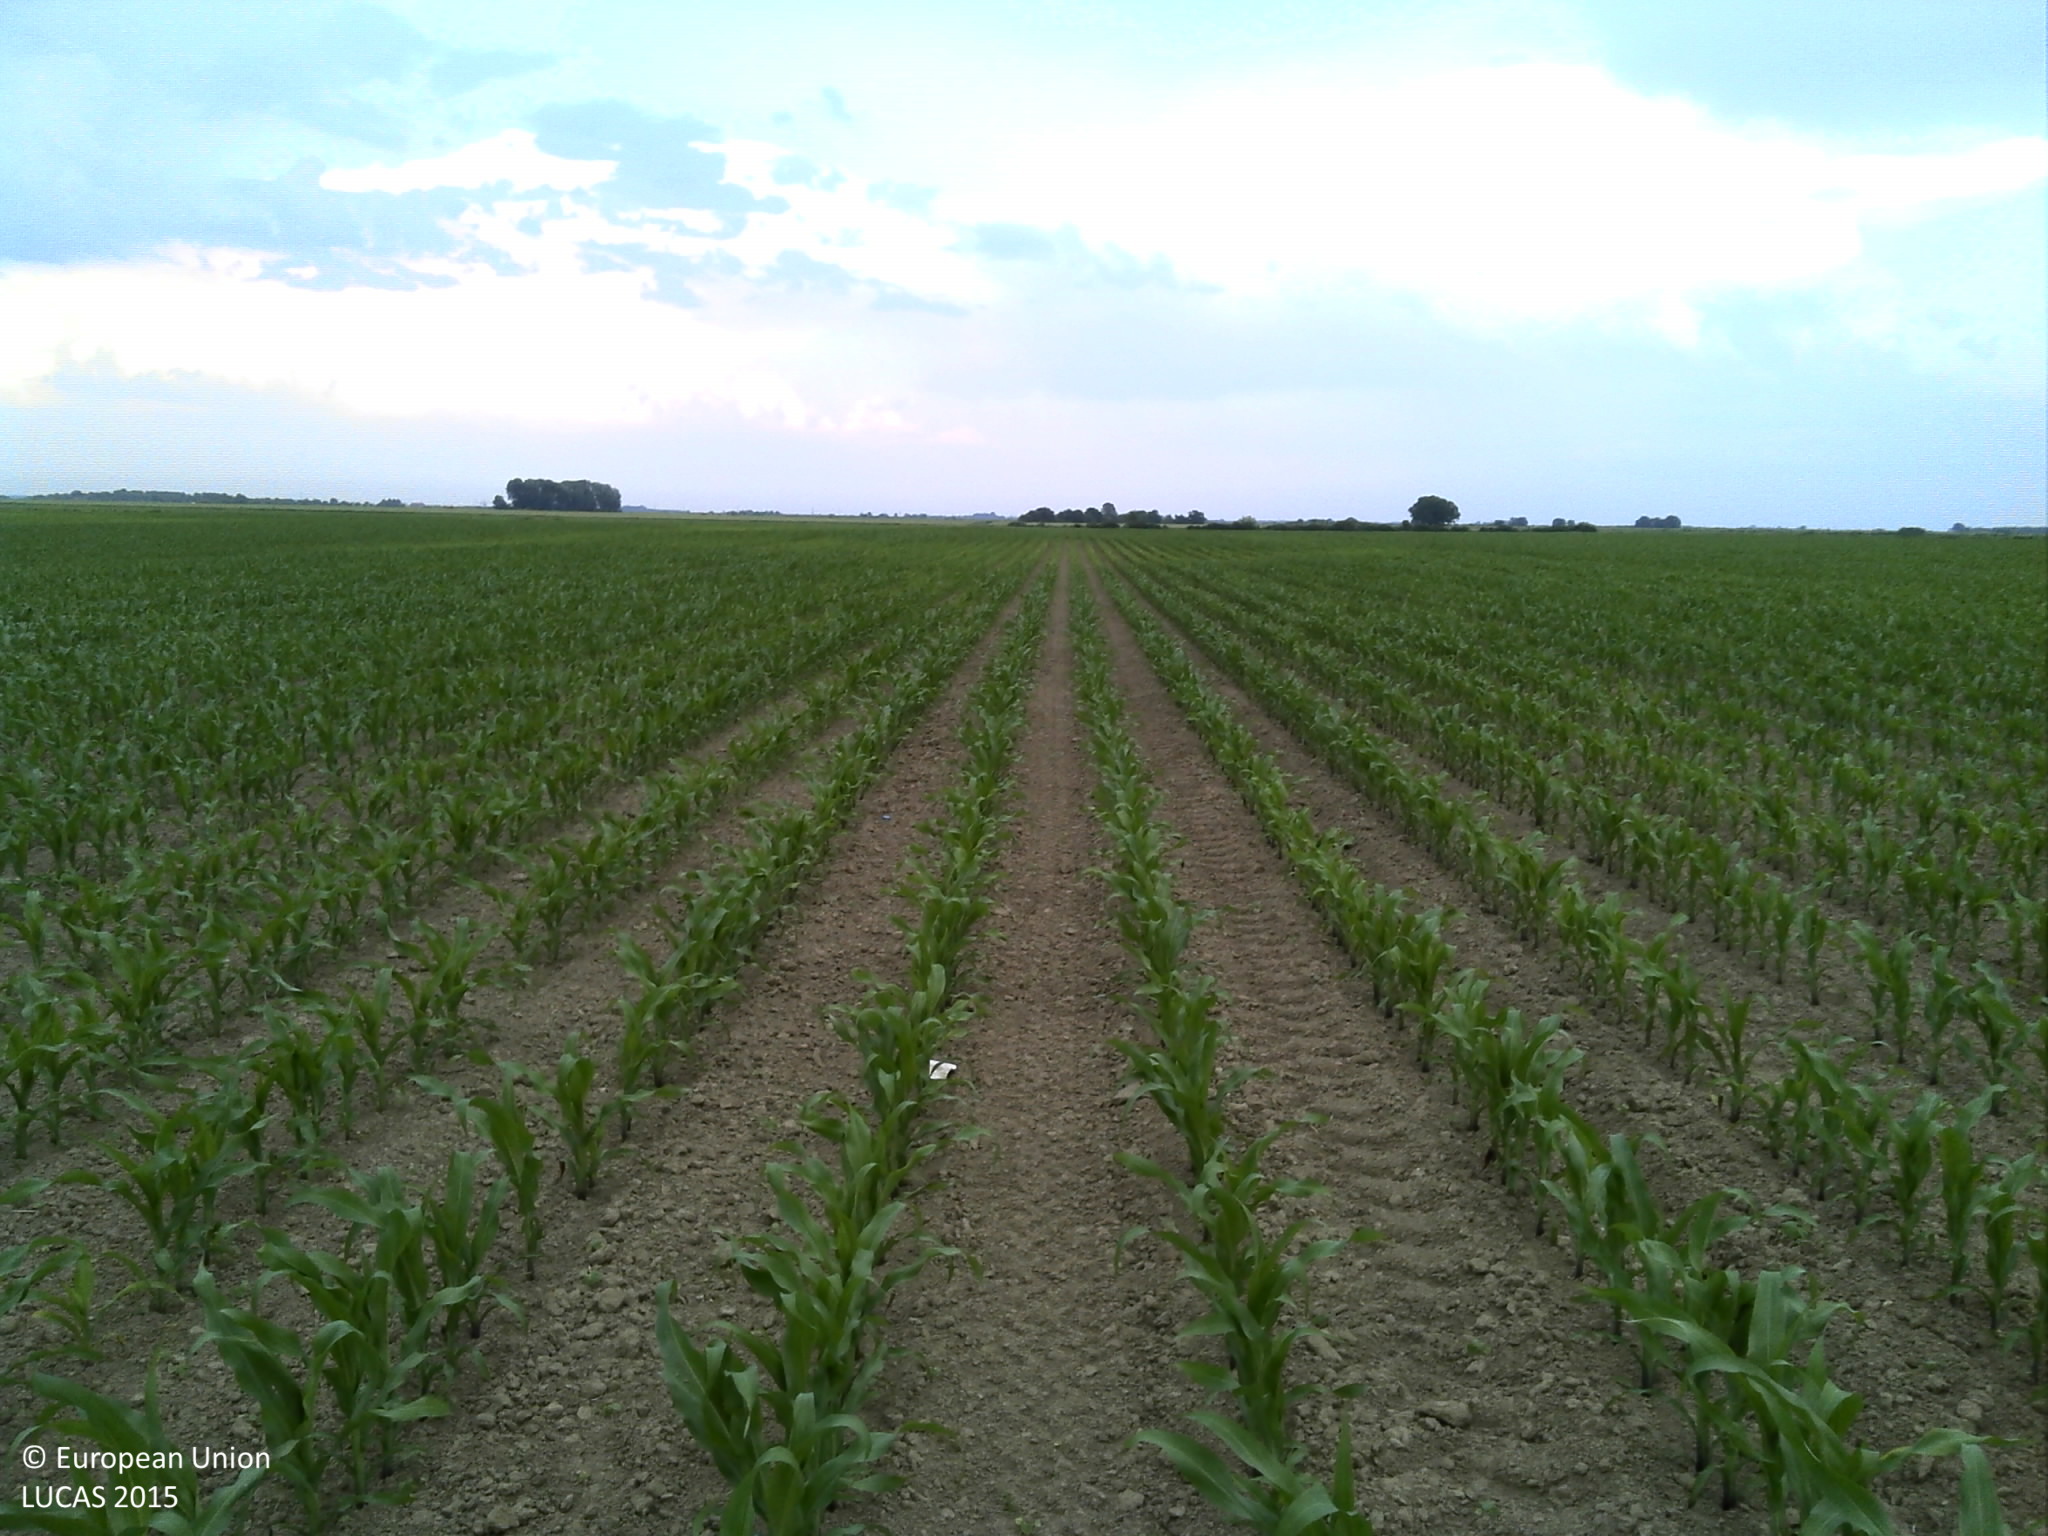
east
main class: Cropland
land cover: Maize
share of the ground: 25 - 50 %
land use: Agriculture (excluding fallow land and kitchen gardens)
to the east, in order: Maize
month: May
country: HR
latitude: 45.5438
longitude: 18.4722
